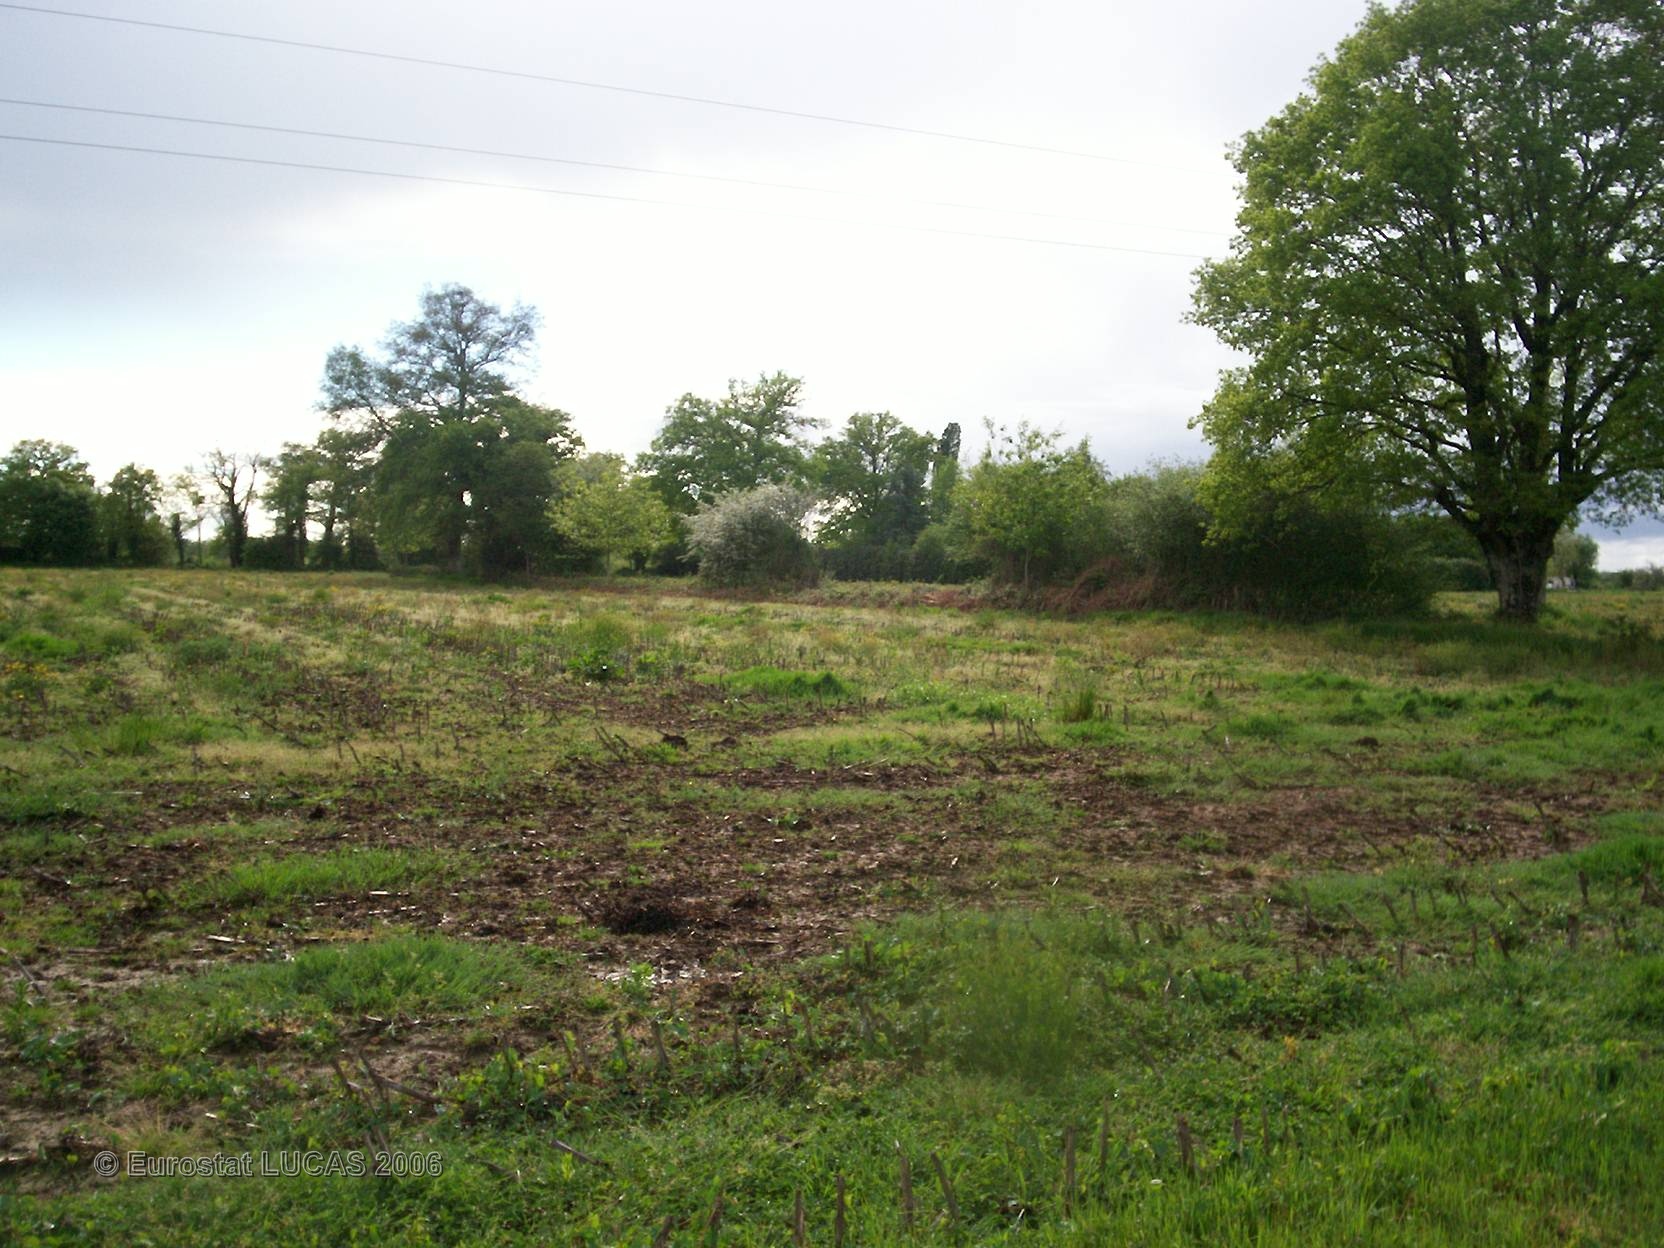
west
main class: Grassland
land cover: Grassland without tree/shrub cover
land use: Agriculture (excluding fallow land and kitchen gardens)
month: May
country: FR
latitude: 45.9304
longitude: 0.5323
